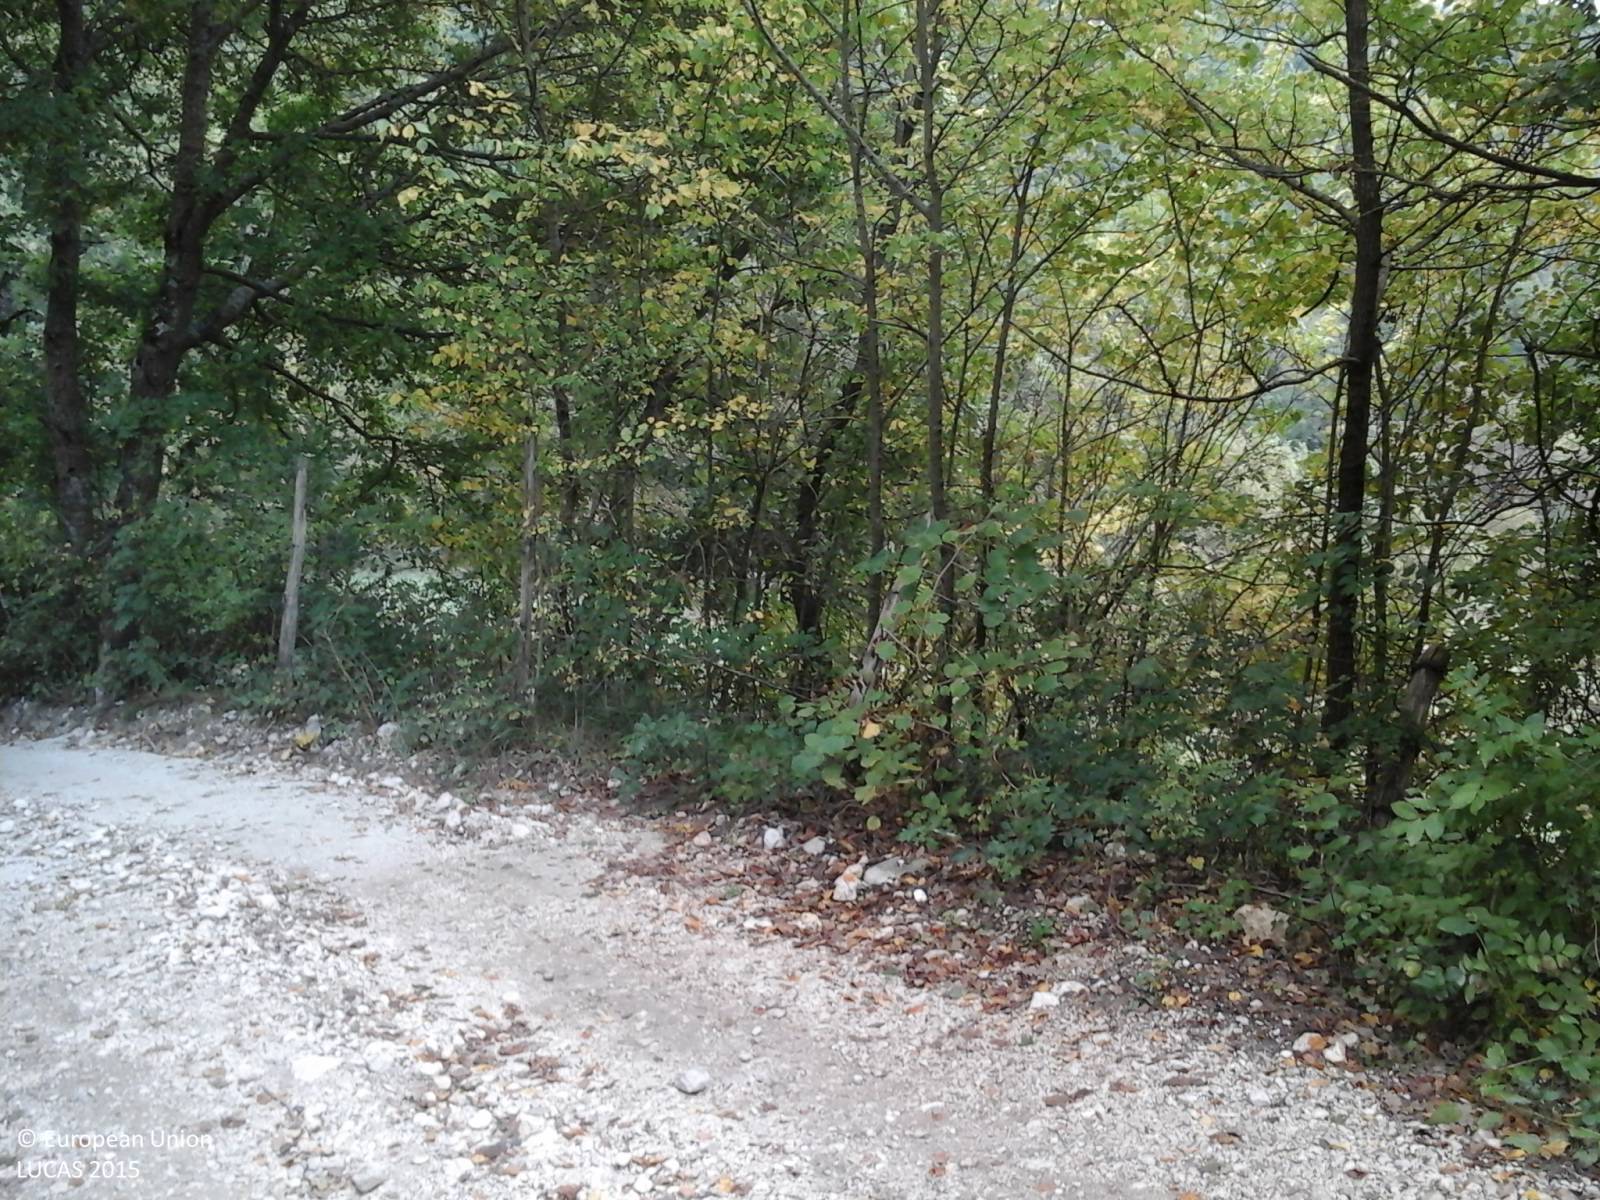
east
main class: Grassland
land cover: Grassland without tree/shrub cover
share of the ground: > 75 %
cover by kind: herbaceous plants 100 %
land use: Agriculture (excluding fallow land and kitchen gardens)
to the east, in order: Grassland without tree/shrub cover; Broadleaved woodland; Grassland without tree/shrub cover; Broadleaved woodland; Tracks; Broadleaved woodland; Grassland without tree/shrub cover; Fences; Grassland without tree/shrub cover; Broadleaved woodland
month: October
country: IT
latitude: 42.2608
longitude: 13.1776
